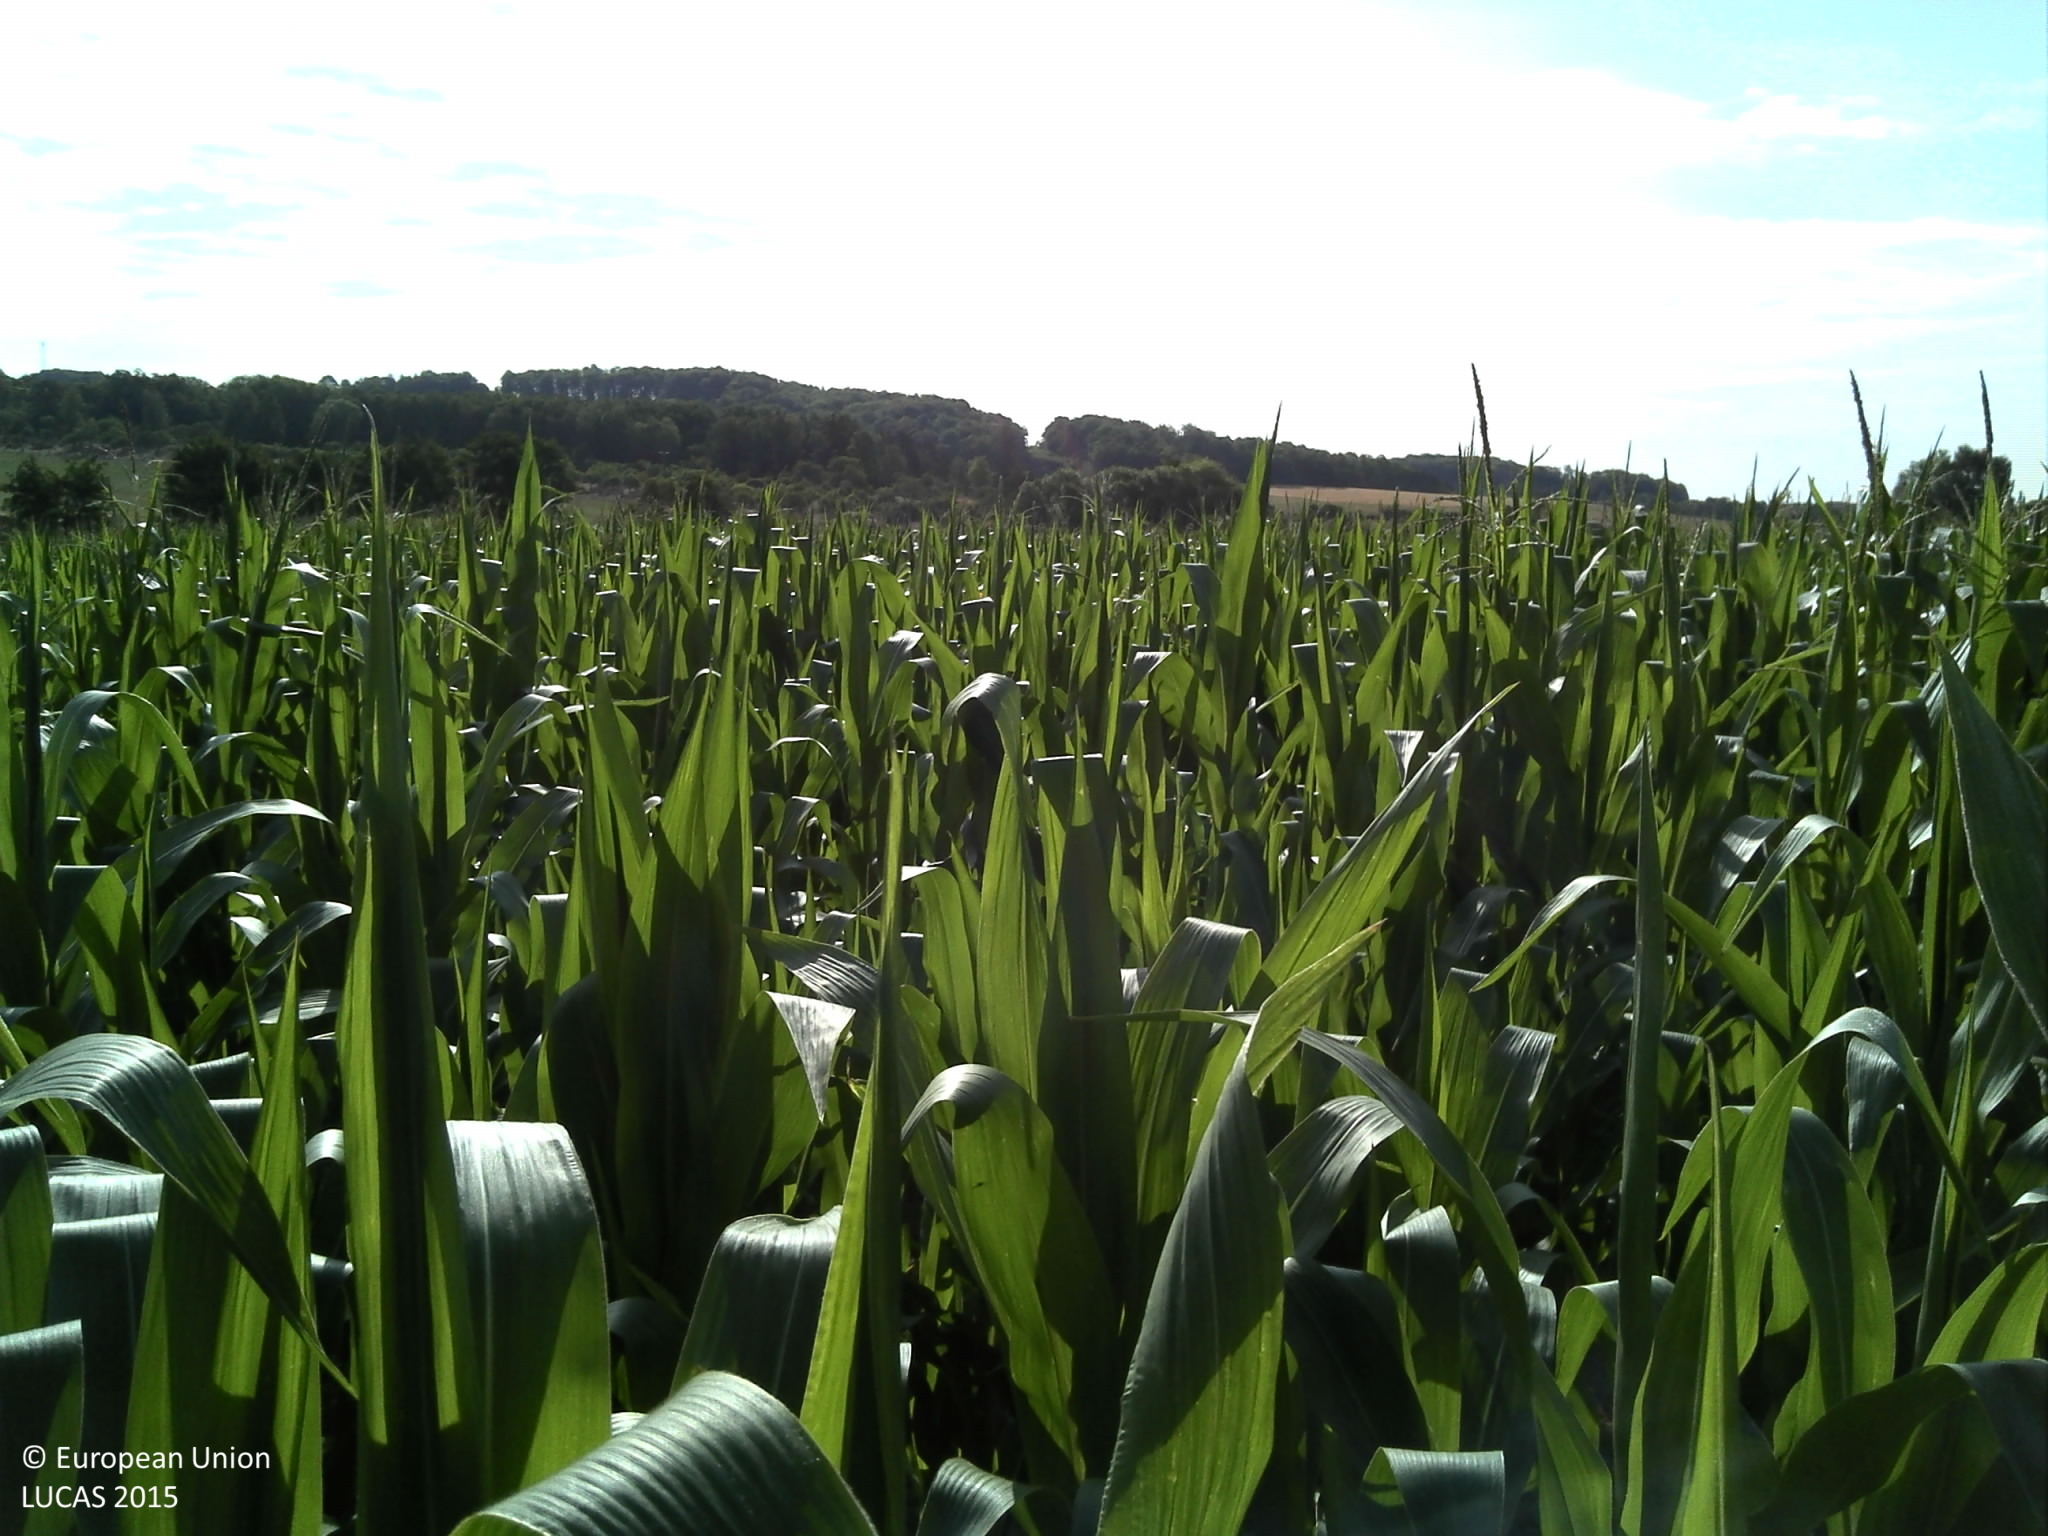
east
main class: Cropland
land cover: Maize
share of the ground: > 75 %
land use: Agriculture (excluding fallow land and kitchen gardens)
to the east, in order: Maize; Spontaneously vegetated surfaces; Lines of trees; Rivers and streams; Grassland without tree/shrub cover; Other bare soil
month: July
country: FR
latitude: 48.3583
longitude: 6.2620
